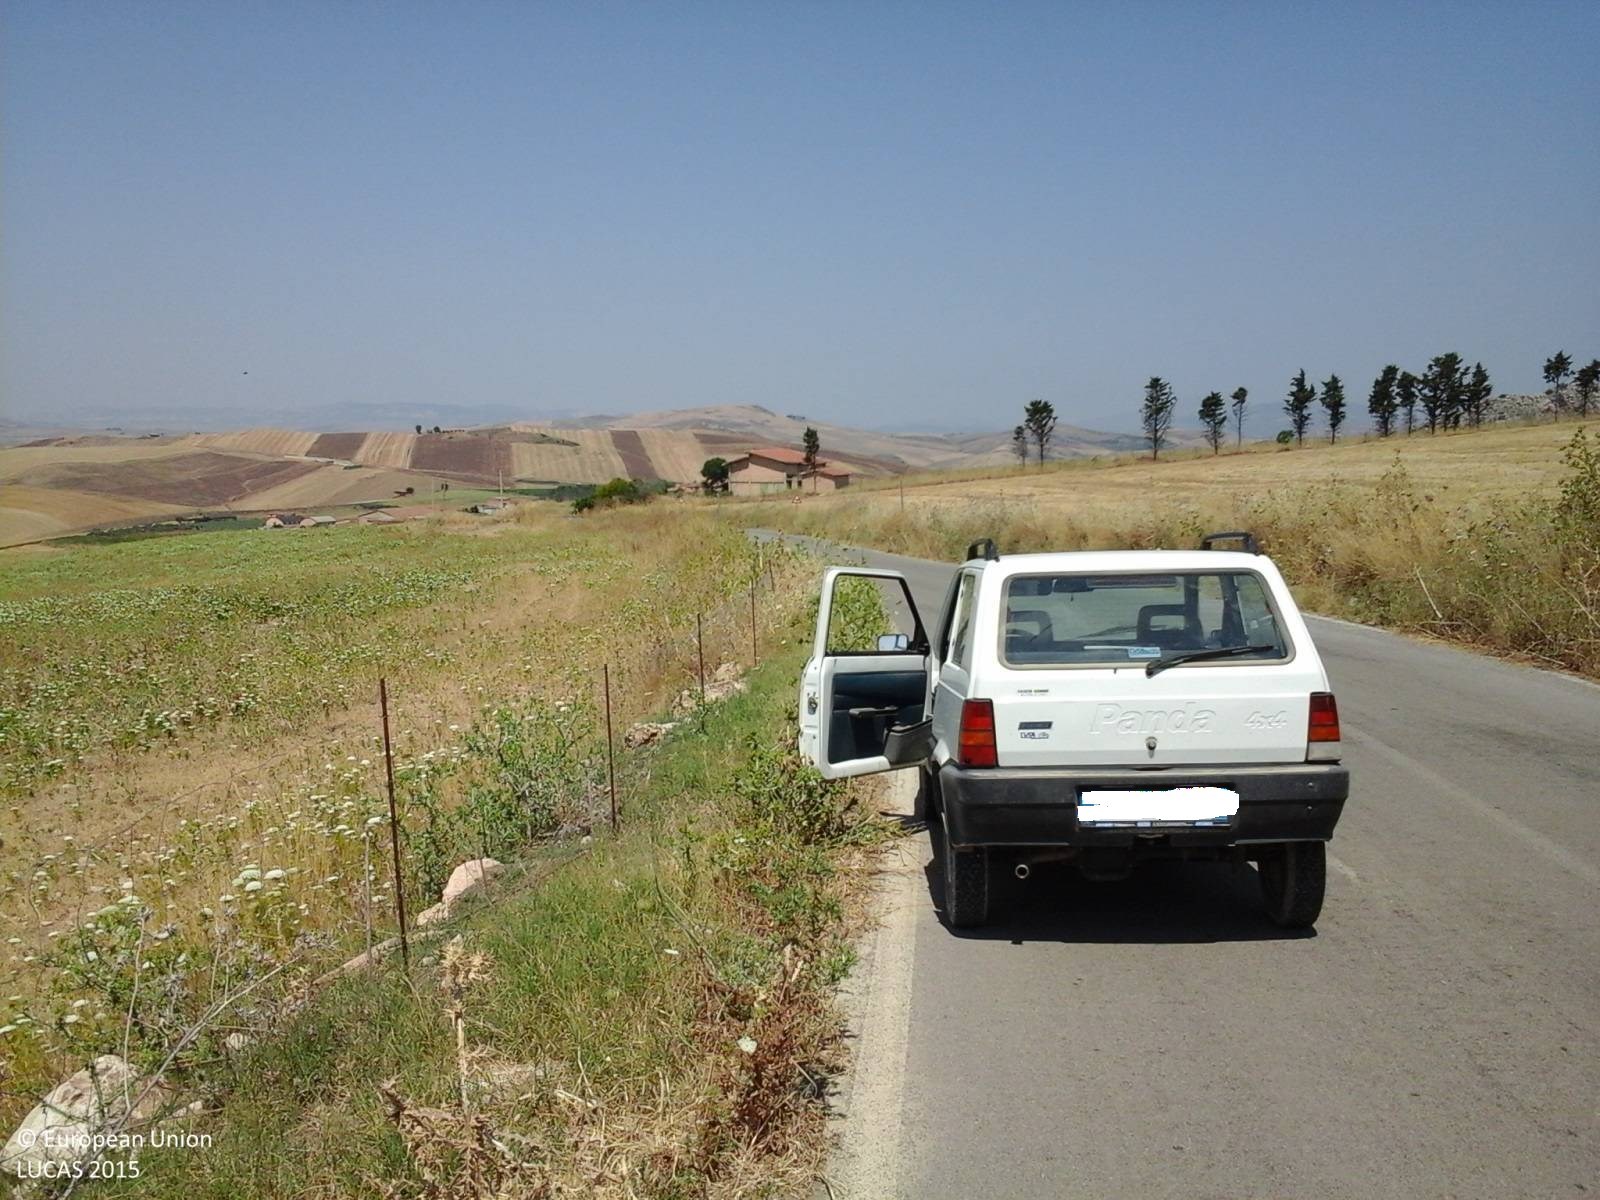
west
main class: Grassland
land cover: Spontaneously vegetated surfaces
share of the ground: > 75 %
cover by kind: herbaceous plants 100 %
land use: Fallow land
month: July
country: IT
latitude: 37.8227
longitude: 13.1465
